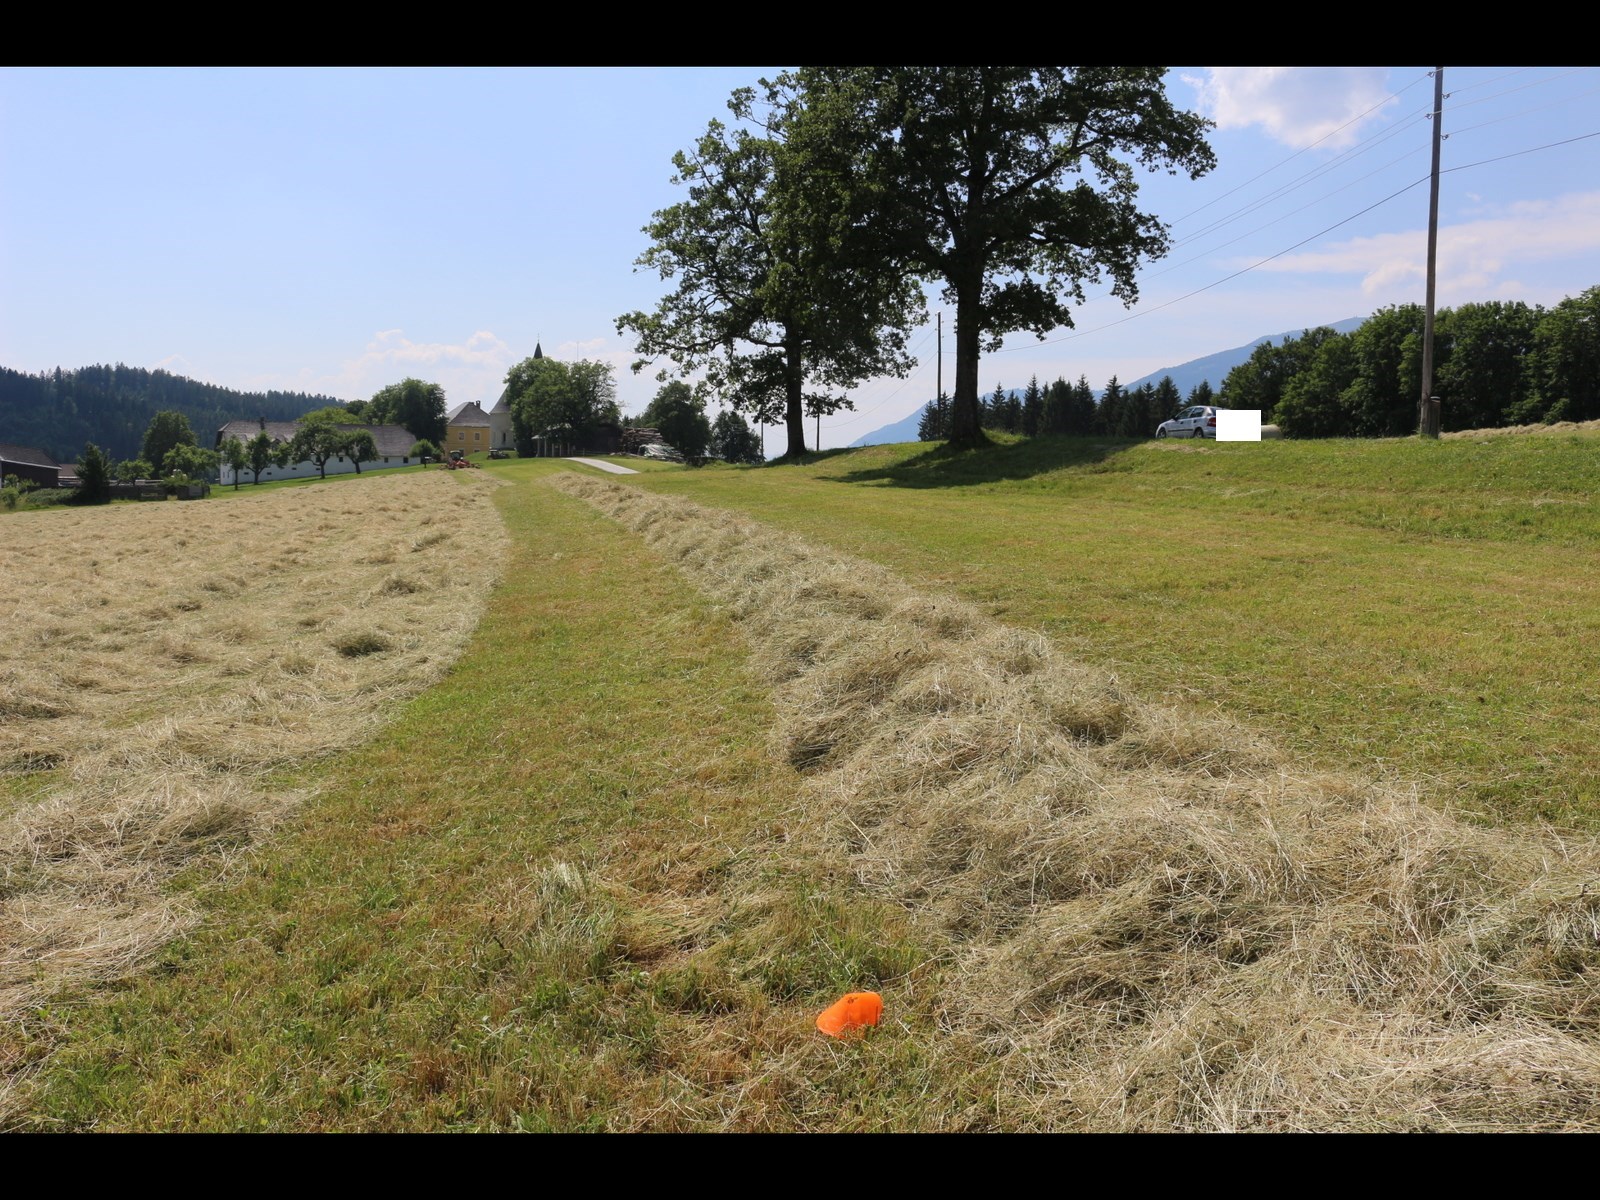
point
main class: Grassland
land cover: Grassland without tree/shrub cover
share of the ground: > 75 %
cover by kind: herbaceous plants 100 %
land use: Agriculture (excluding fallow land and kitchen gardens)
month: June
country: AT
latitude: 46.6727
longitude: 14.0104
